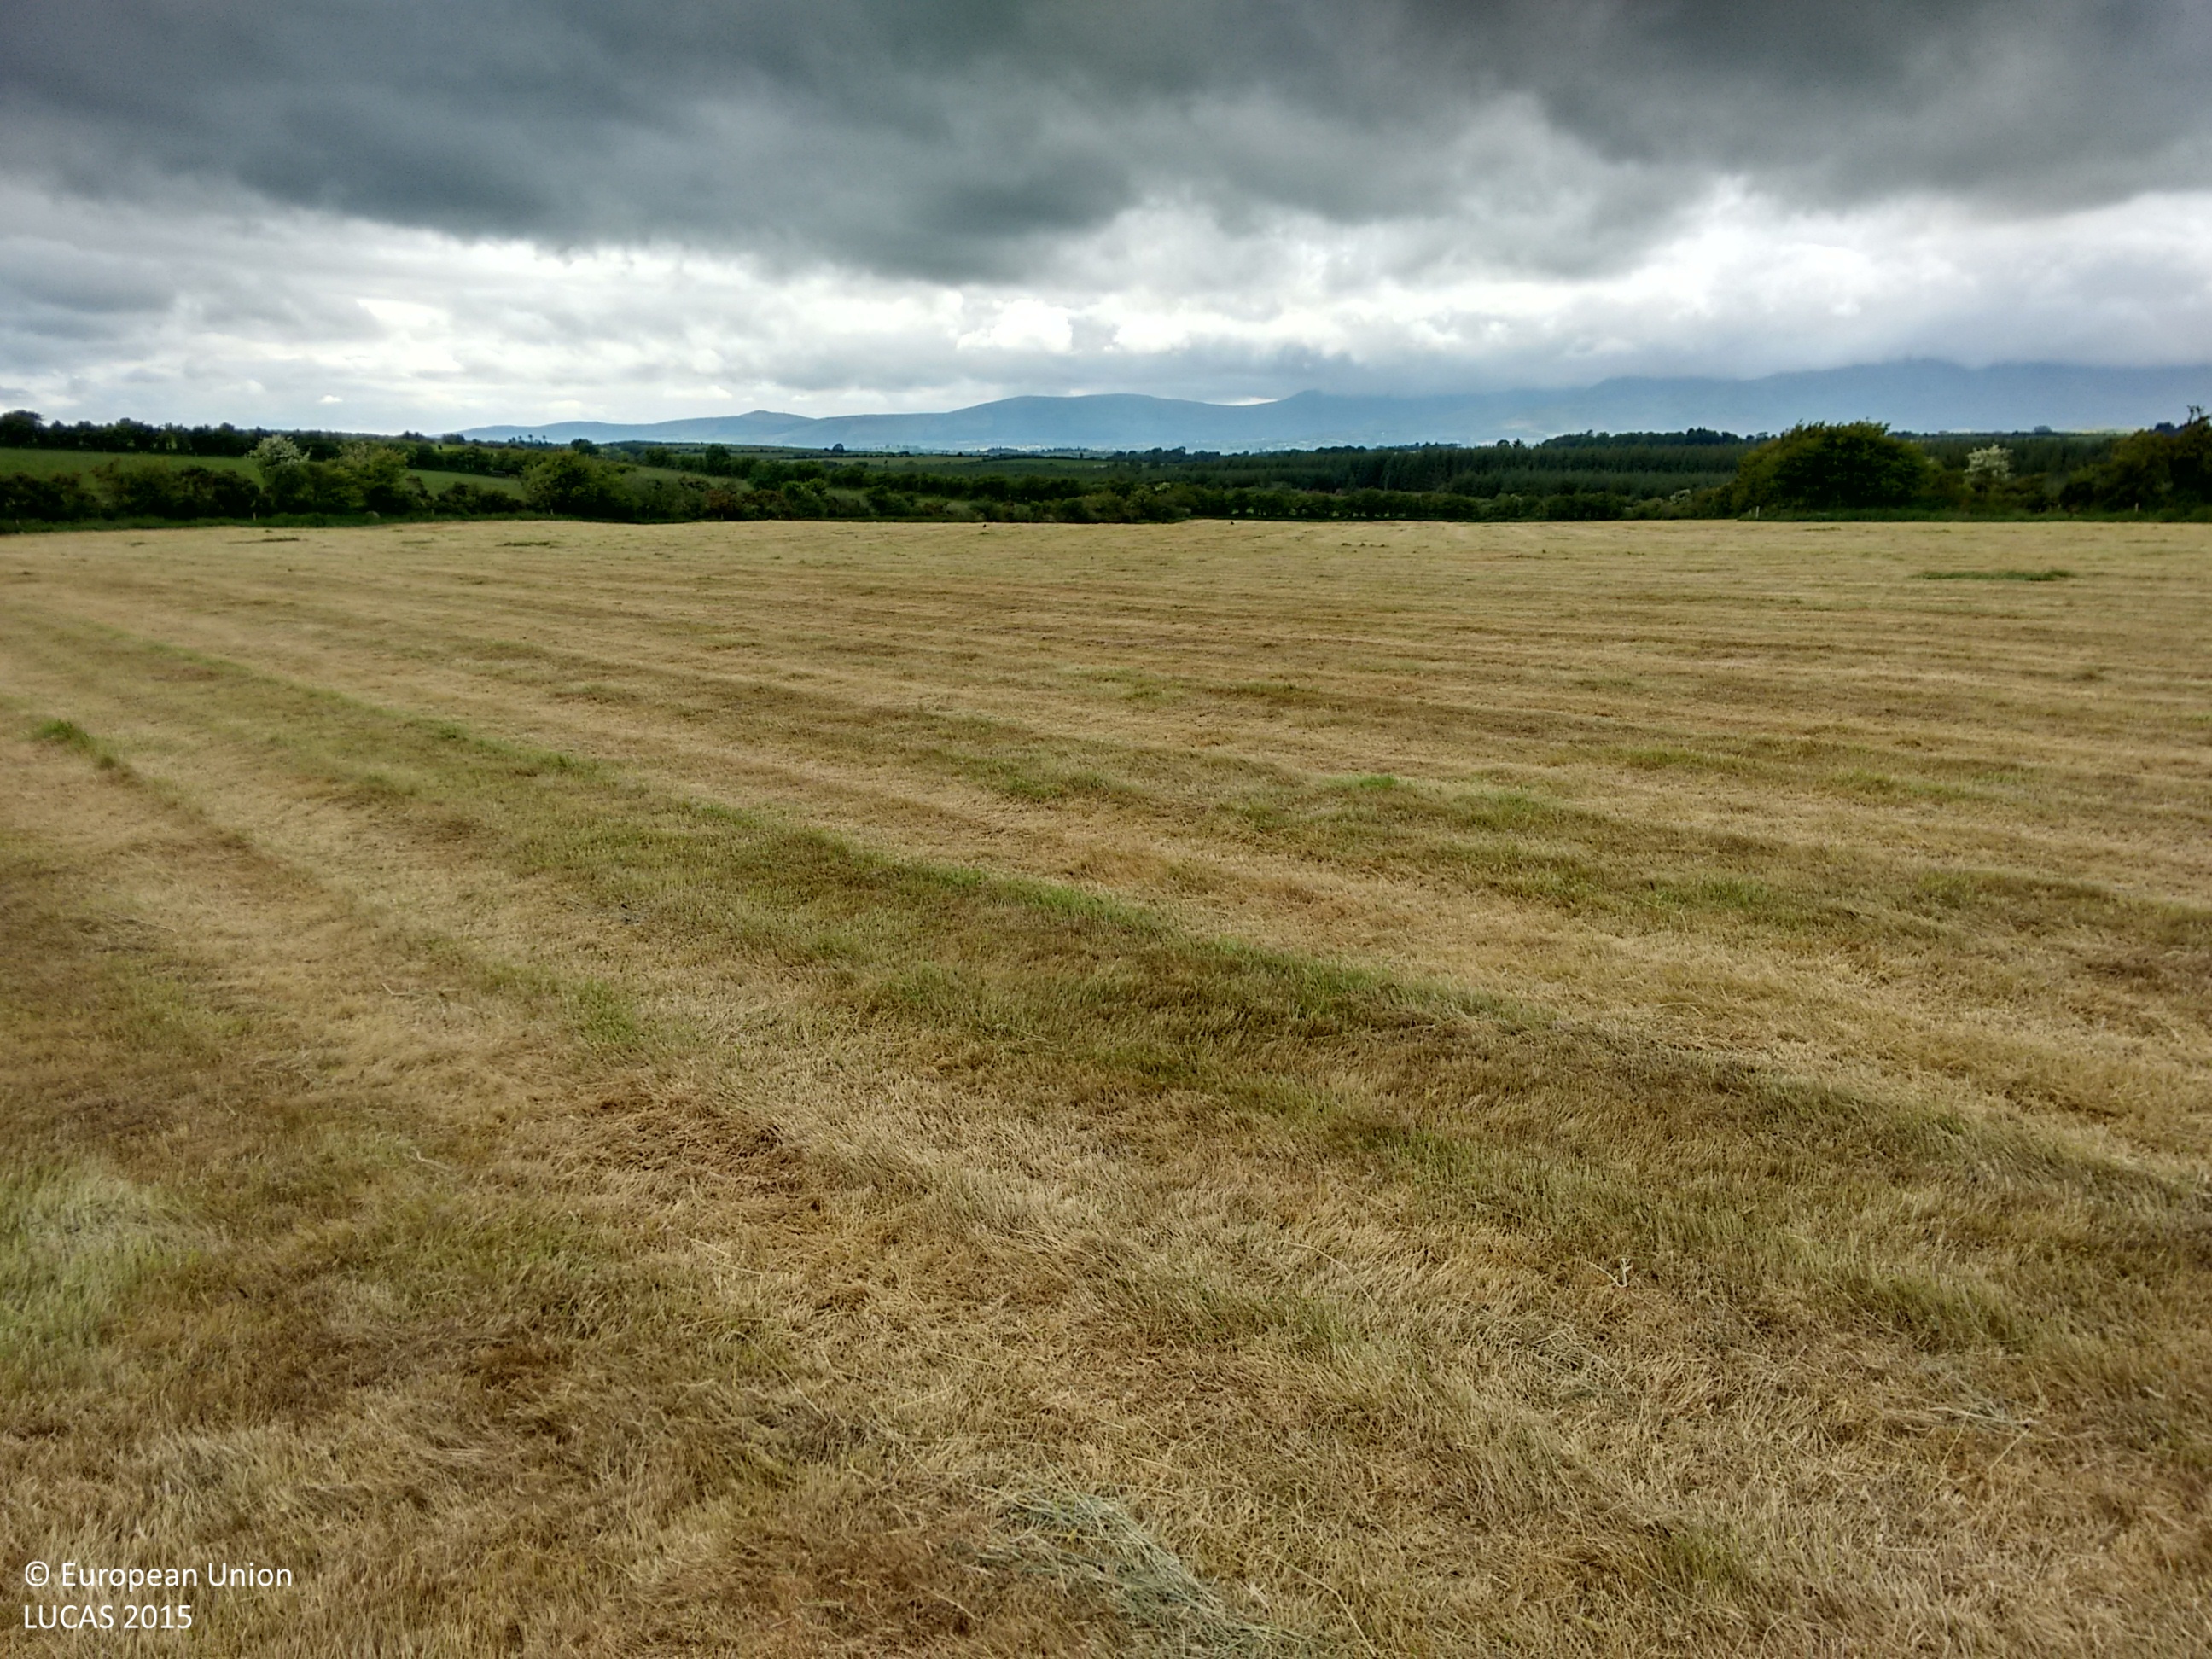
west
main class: Grassland
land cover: Grassland without tree/shrub cover
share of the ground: > 75 %
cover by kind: herbaceous plants 100 %
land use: Agriculture (excluding fallow land and kitchen gardens)
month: June
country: IE
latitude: 52.2088
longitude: -7.3493
